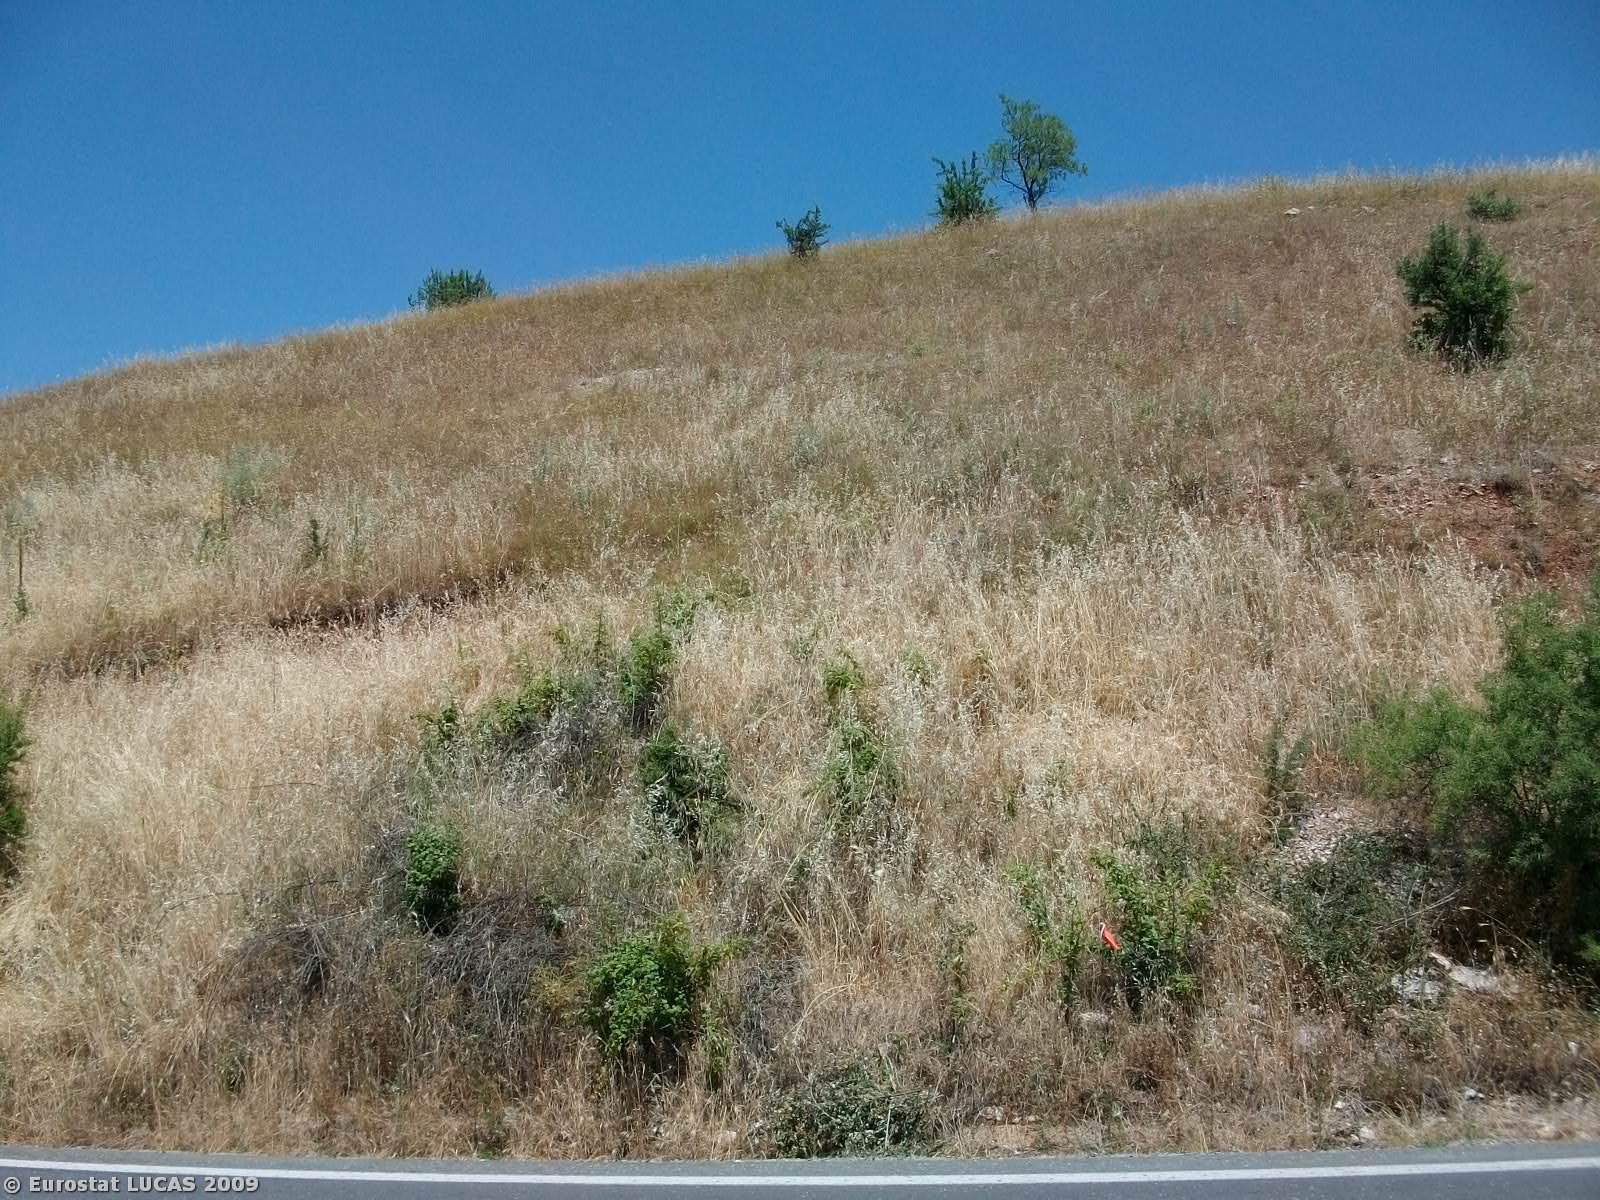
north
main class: Grassland
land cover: Grassland without tree/shrub cover
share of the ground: 25 - 50 %
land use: Fallow land
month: June
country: GR
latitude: 37.3525
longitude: 22.4120
